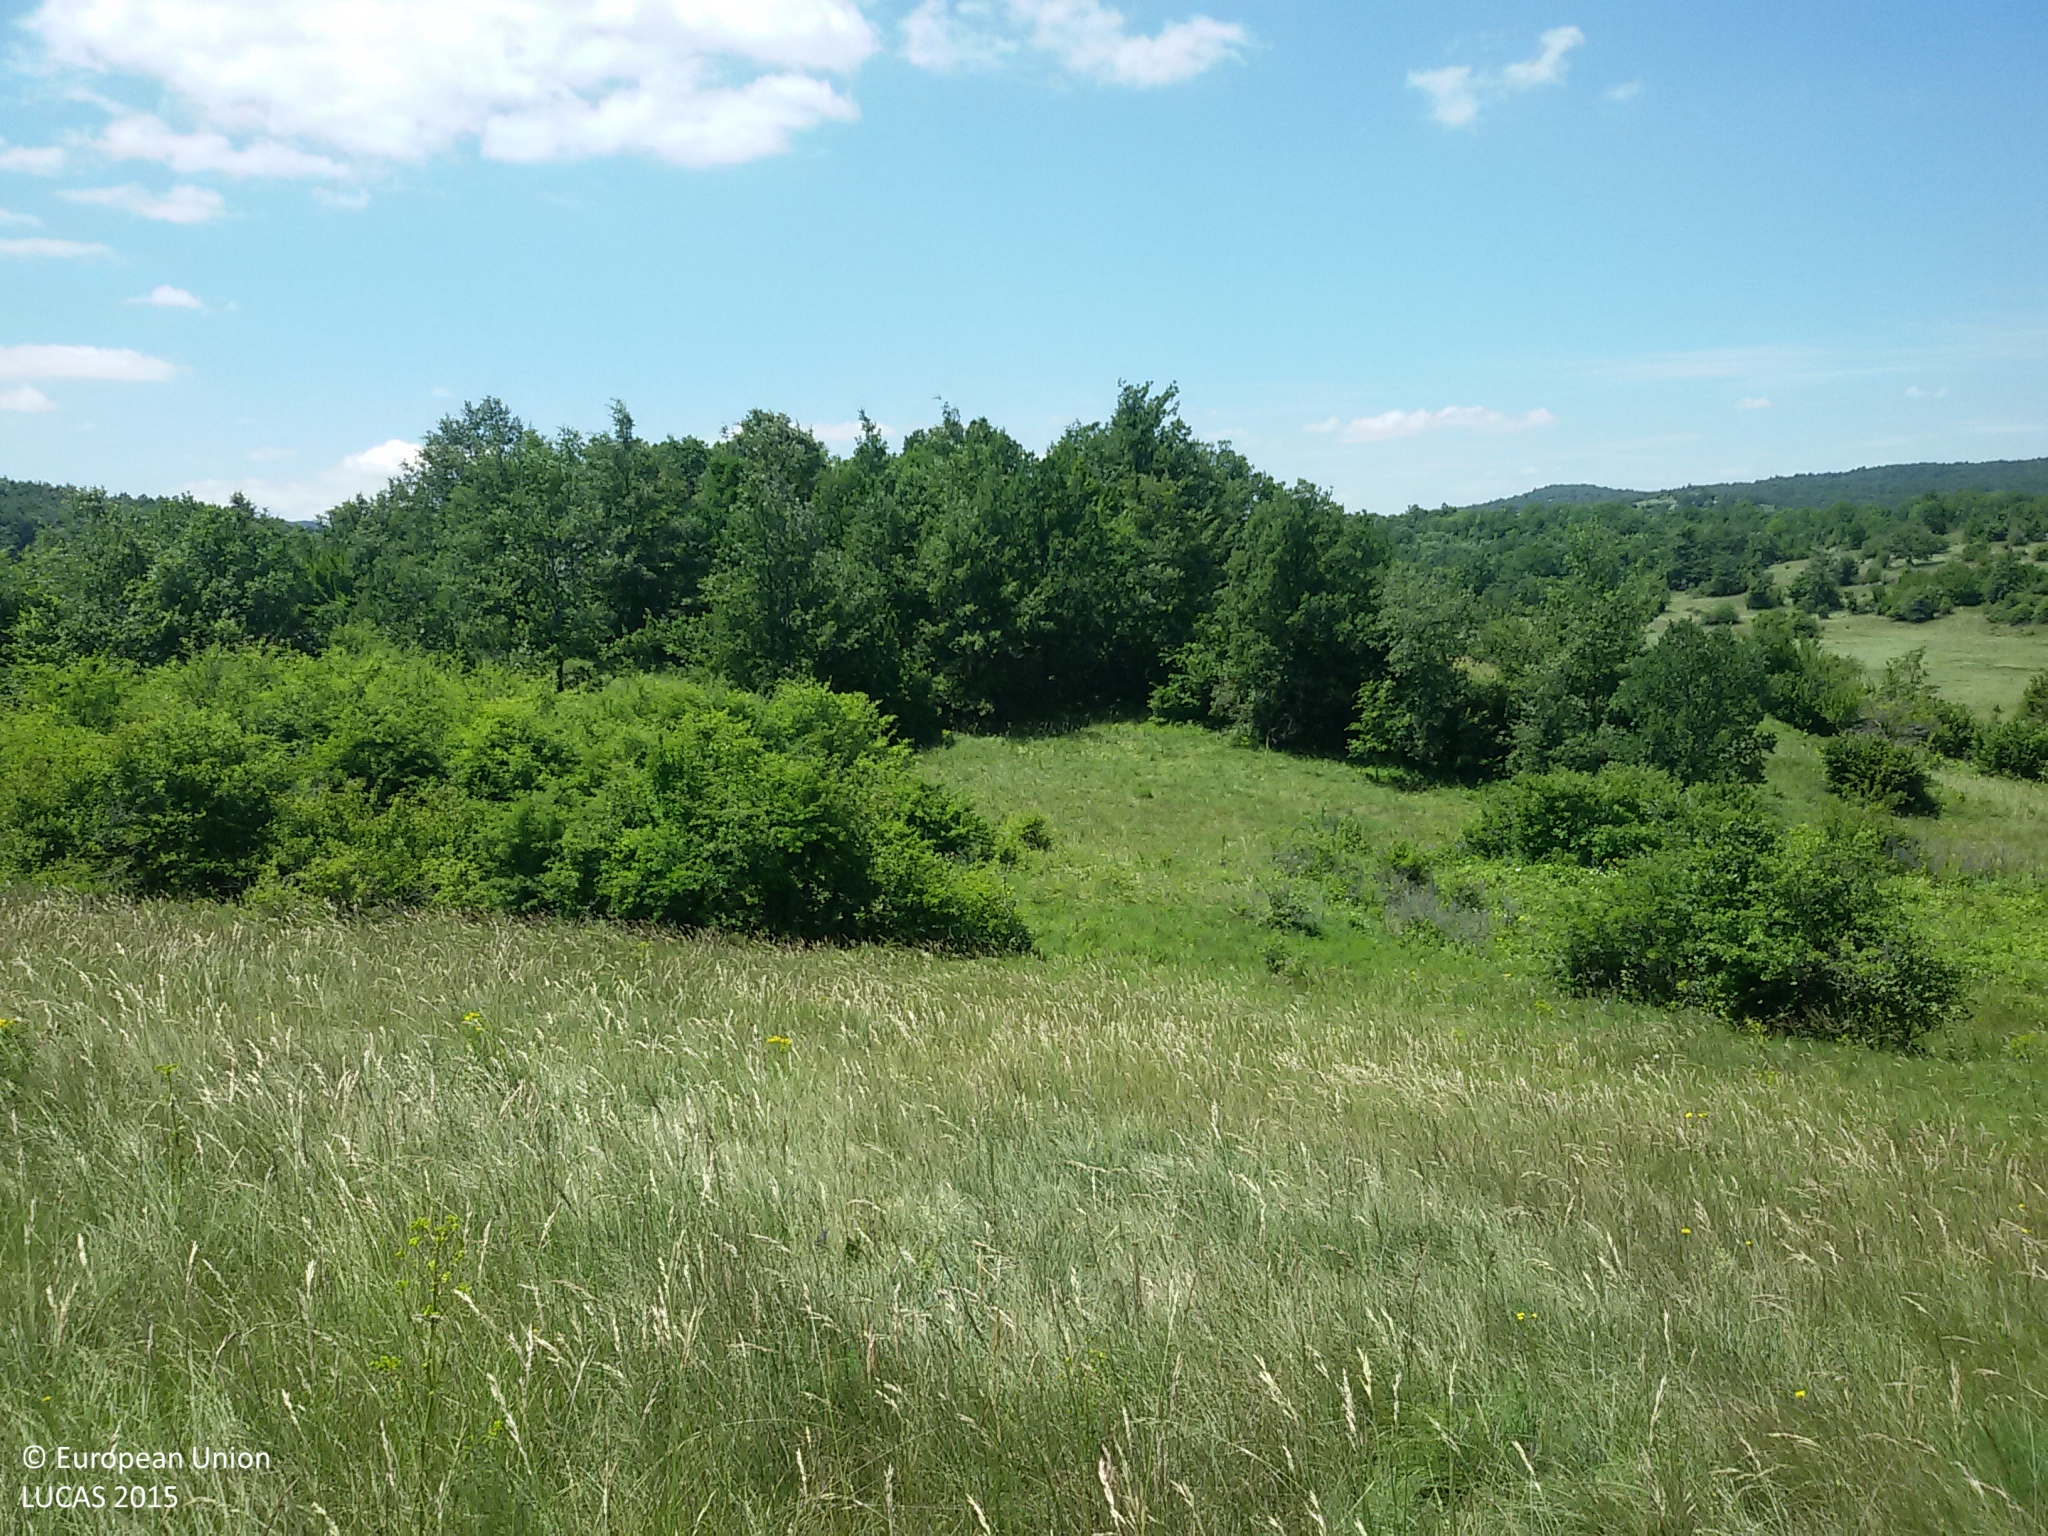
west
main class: Woodland
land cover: Broadleaved woodland
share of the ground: 10 - 25 %
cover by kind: herbaceous plants 55 %, broadleaved forest trees 25 %, shrubs 15 %, unconsolidated bare surface 5 %
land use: Semi-natural and natural areas not in use
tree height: < 5 m
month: June
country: HR
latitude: 44.4989
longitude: 15.7411
